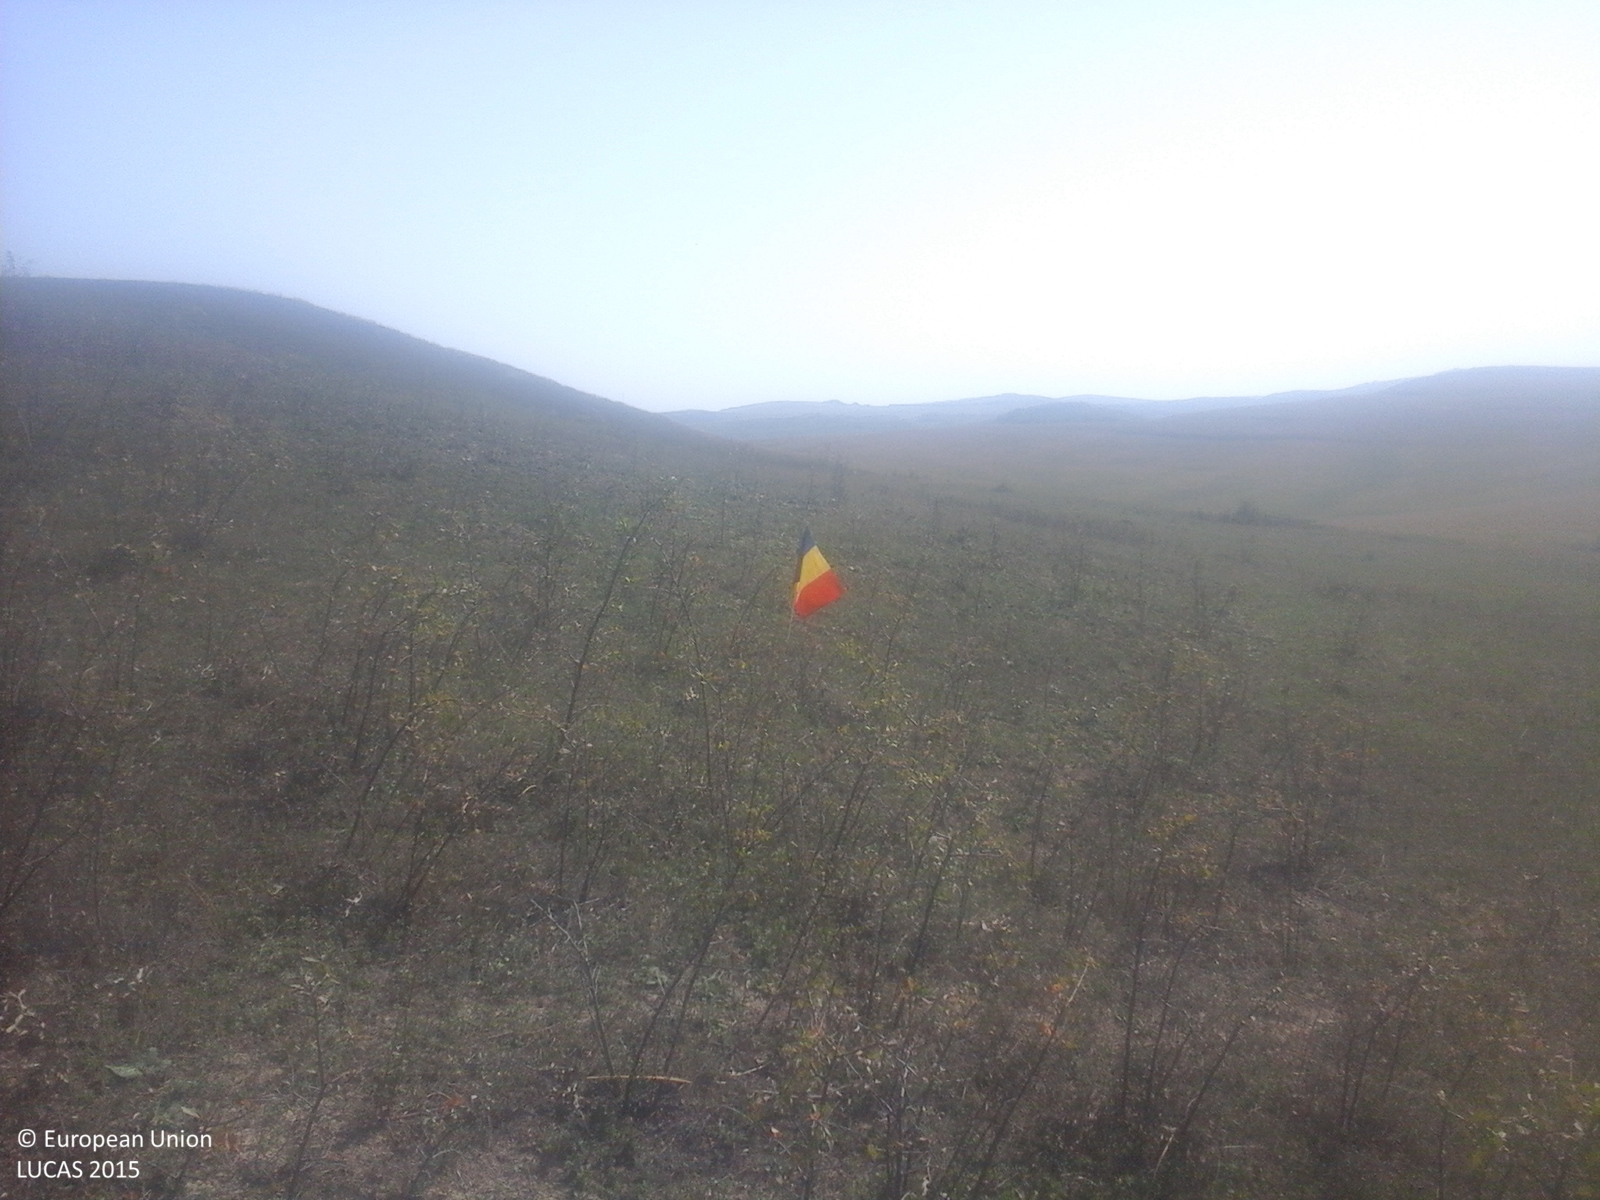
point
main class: Grassland
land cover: Spontaneously vegetated surfaces
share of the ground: > 75 %
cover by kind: herbaceous plants 100 %
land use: Agriculture (excluding fallow land and kitchen gardens)
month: September
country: RO
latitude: 46.8835
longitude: 24.2971
